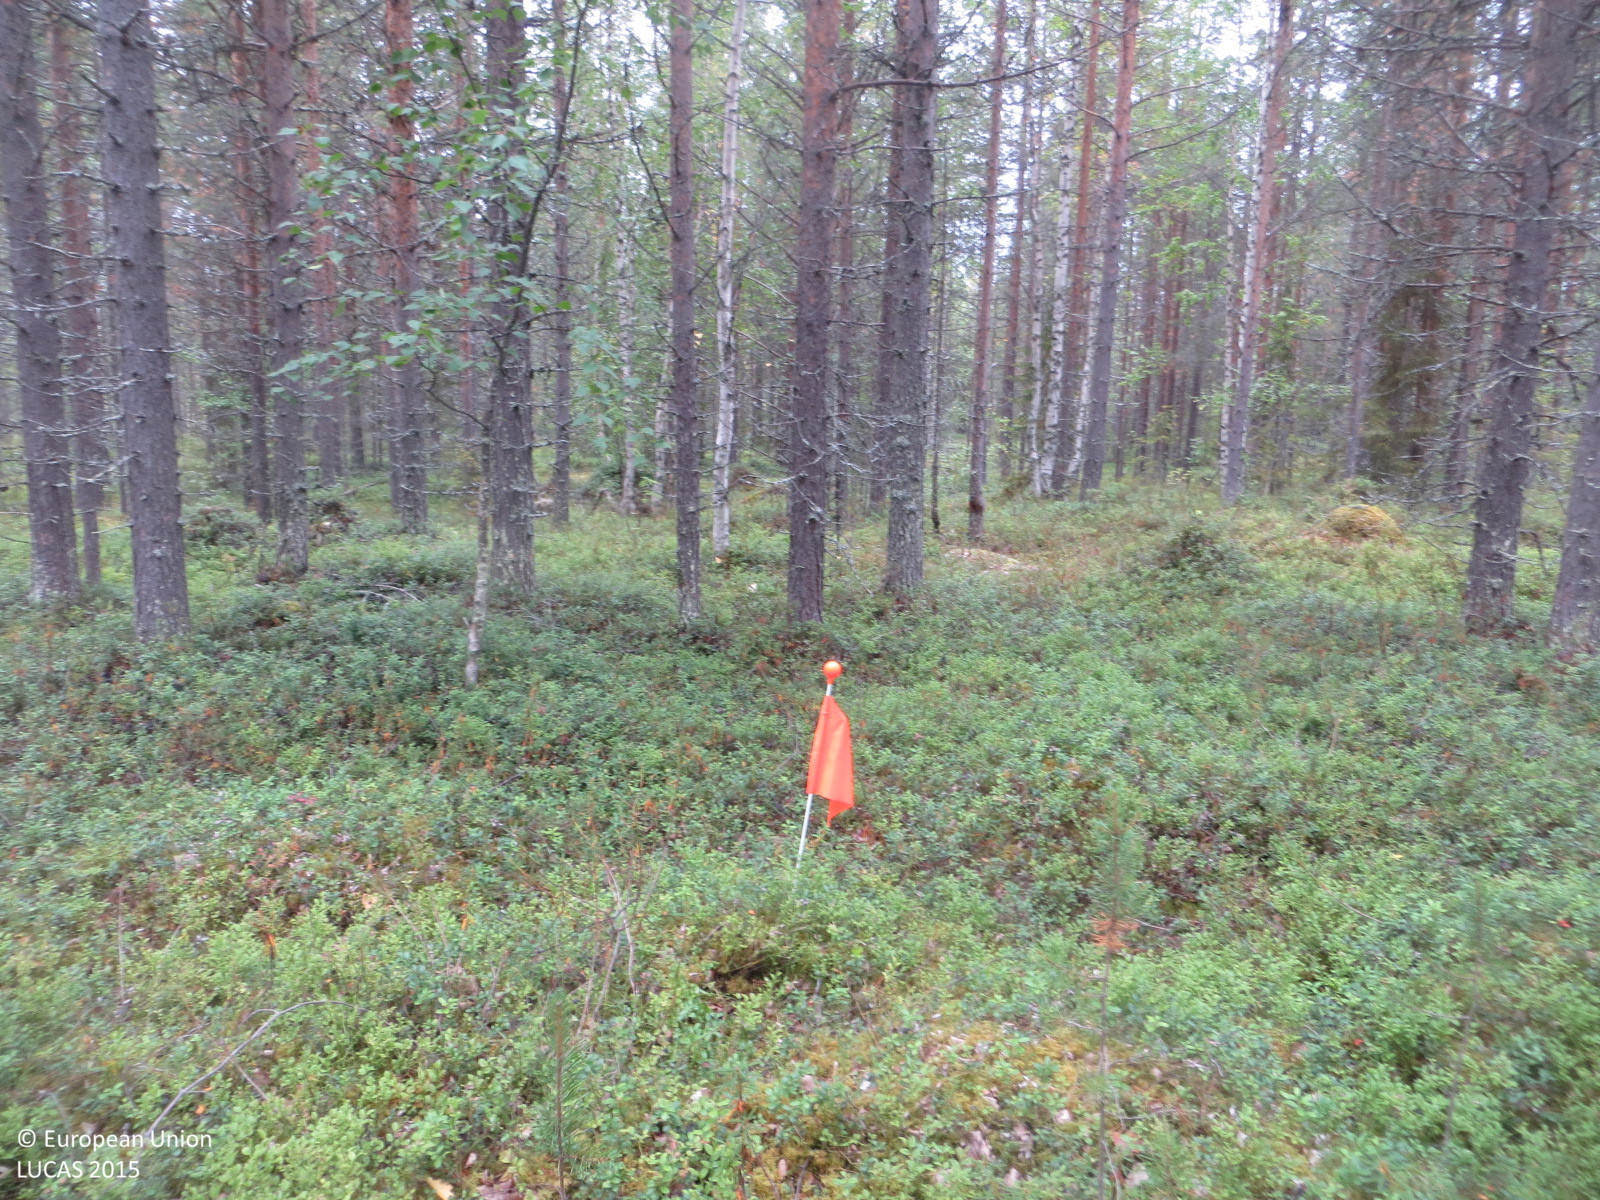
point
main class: Woodland
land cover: Pine dominated mixed woodland
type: boreal forest
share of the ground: 50 - 75 %
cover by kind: coniferous forest trees 45 %, shrubs 40 %, broadleaved forest trees 15 %
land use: Forestry
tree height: > 5 m
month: August
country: FI
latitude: 67.4198
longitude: 24.2877
